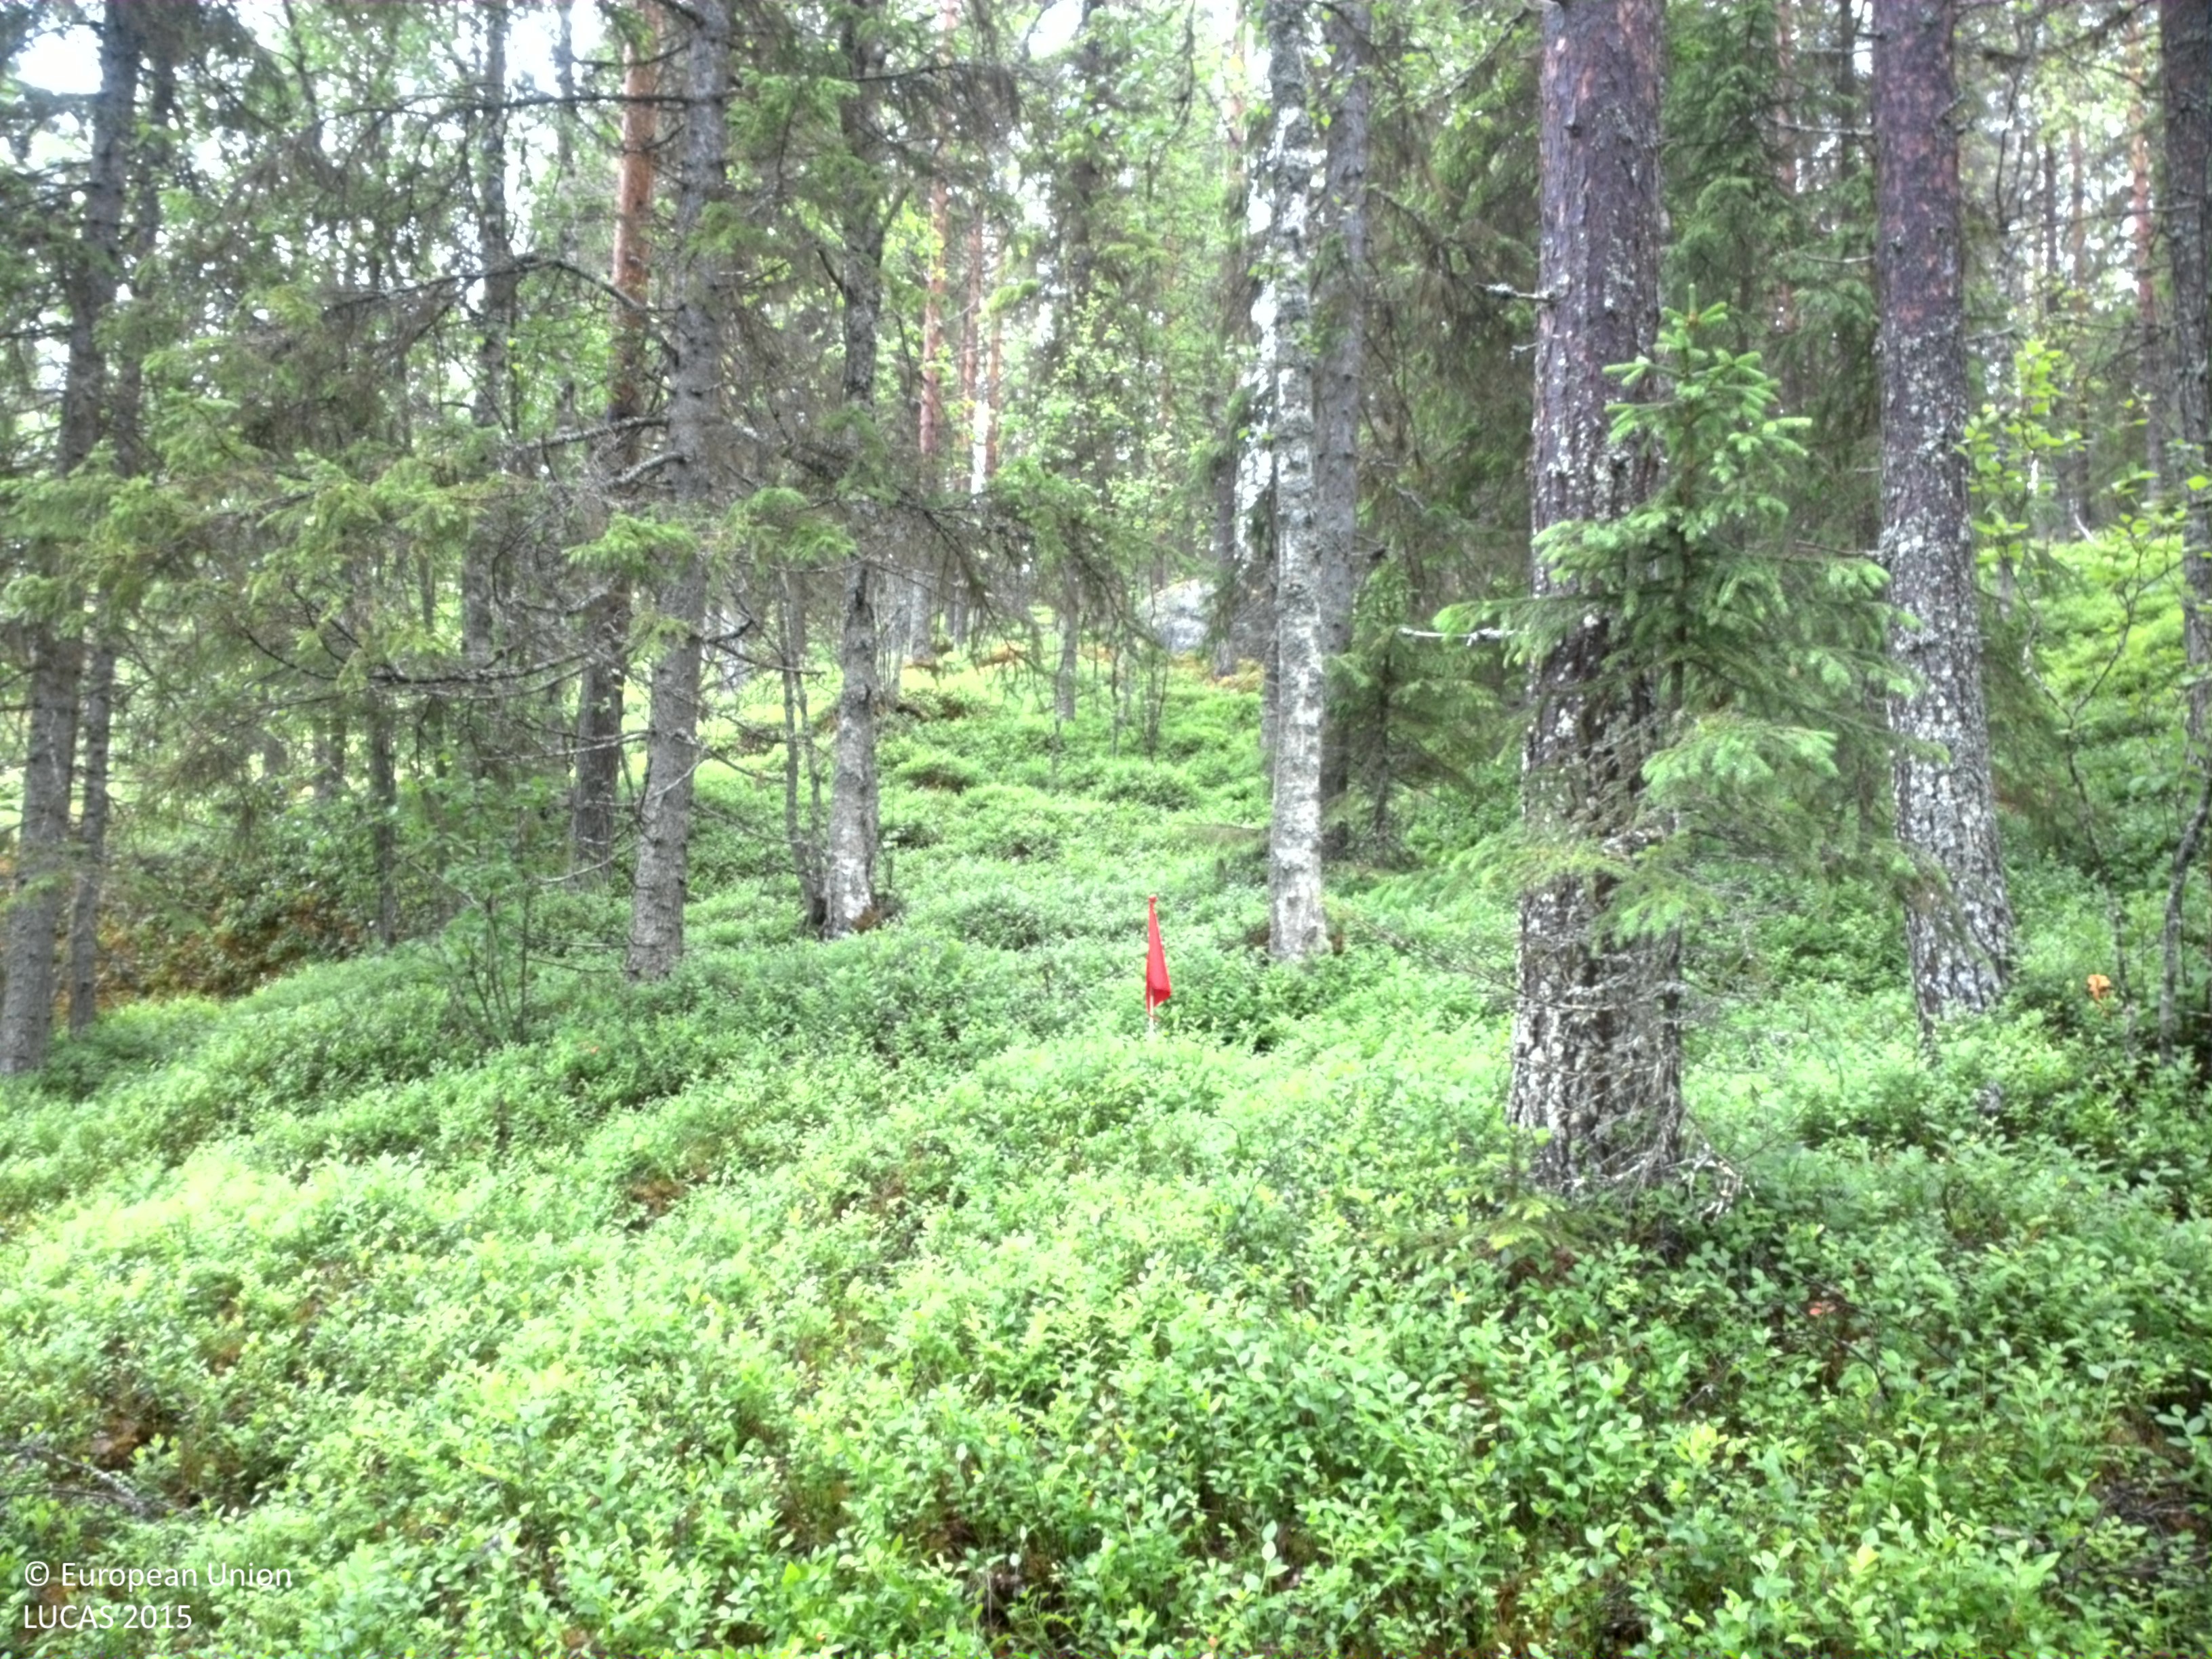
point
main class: Woodland
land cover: Pine dominated coniferous woodland
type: hemiboreal forest and nemoral coniferous forest and mixed broadleaved-coniferous forest
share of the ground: 50 - 75 %
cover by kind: coniferous forest trees 65 %, shrubs 20 %, broadleaved forest trees 10 %, lichens and mosses 5 %
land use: Forestry
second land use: Amenities, museums, leisure
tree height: > 5 m
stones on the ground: 10 - 25 %
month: July
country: SE
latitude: 64.6207
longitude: 18.2267
